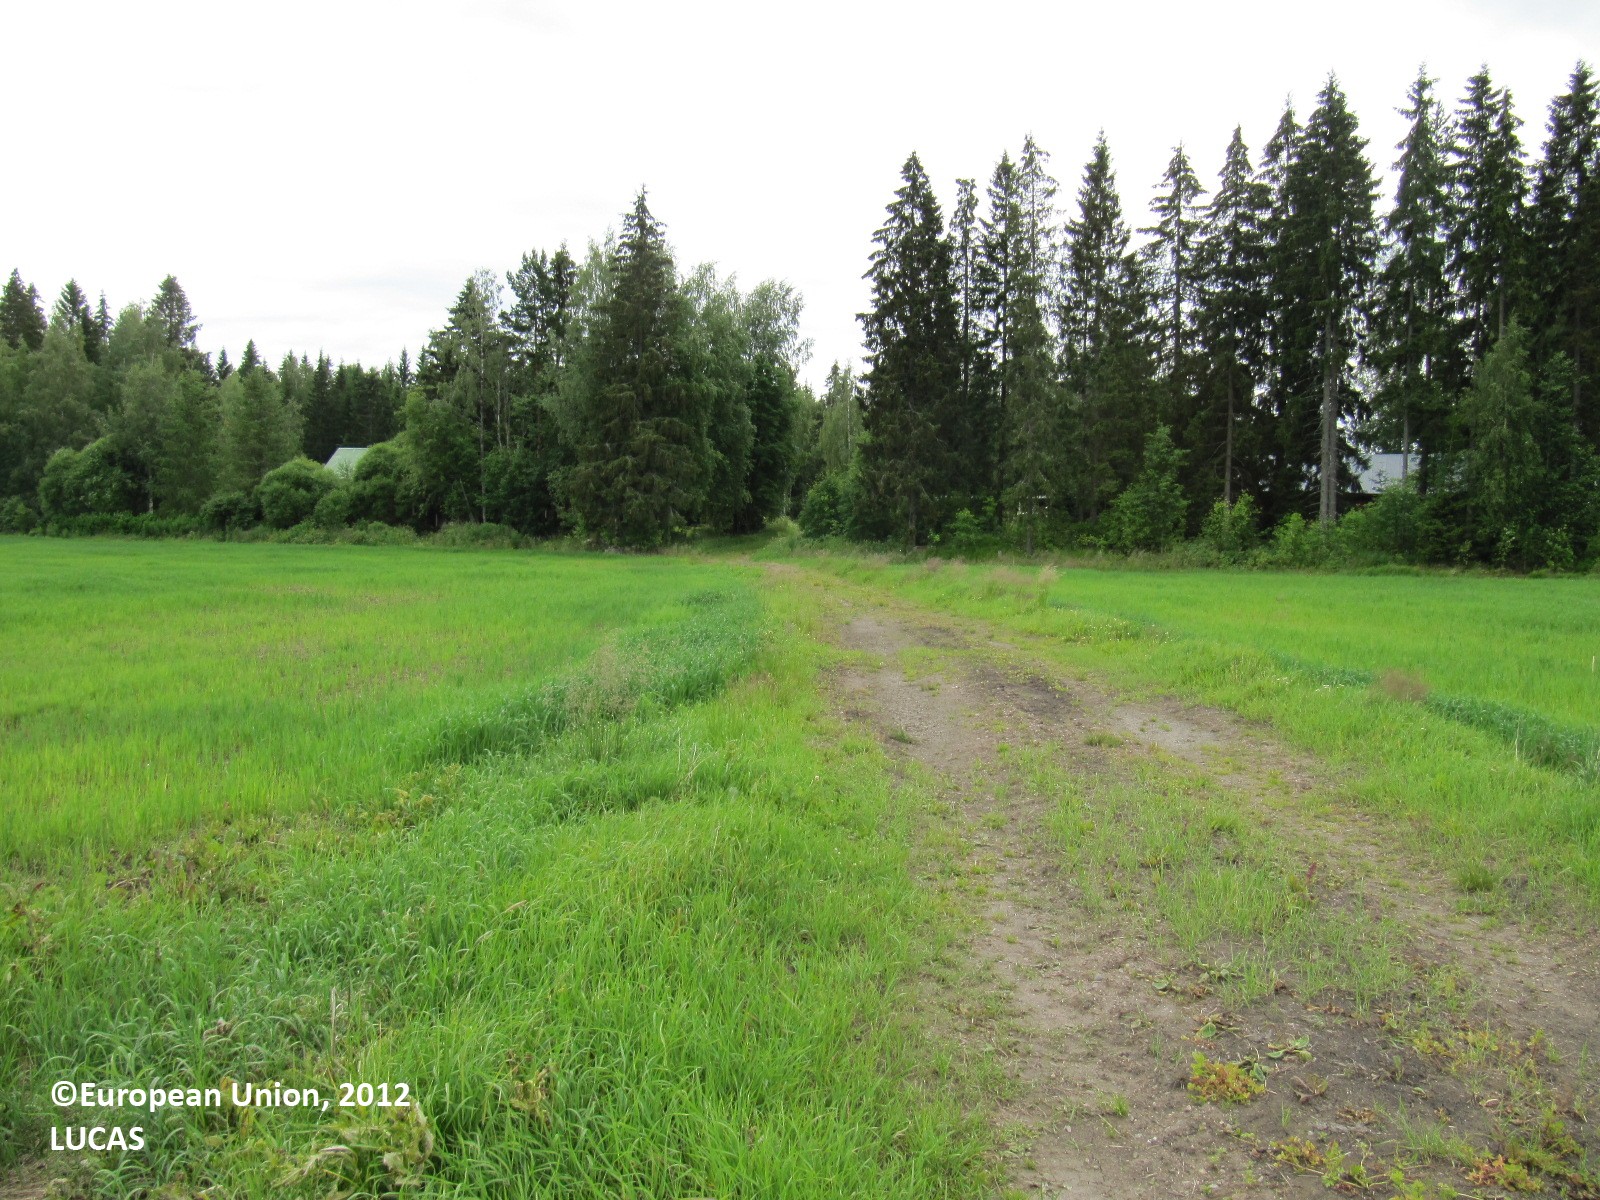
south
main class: Cropland
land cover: Oats
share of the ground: 50 - 75 %
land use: Agriculture (excluding fallow land and kitchen gardens)
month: July
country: FI
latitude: 60.9057
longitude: 23.4492
